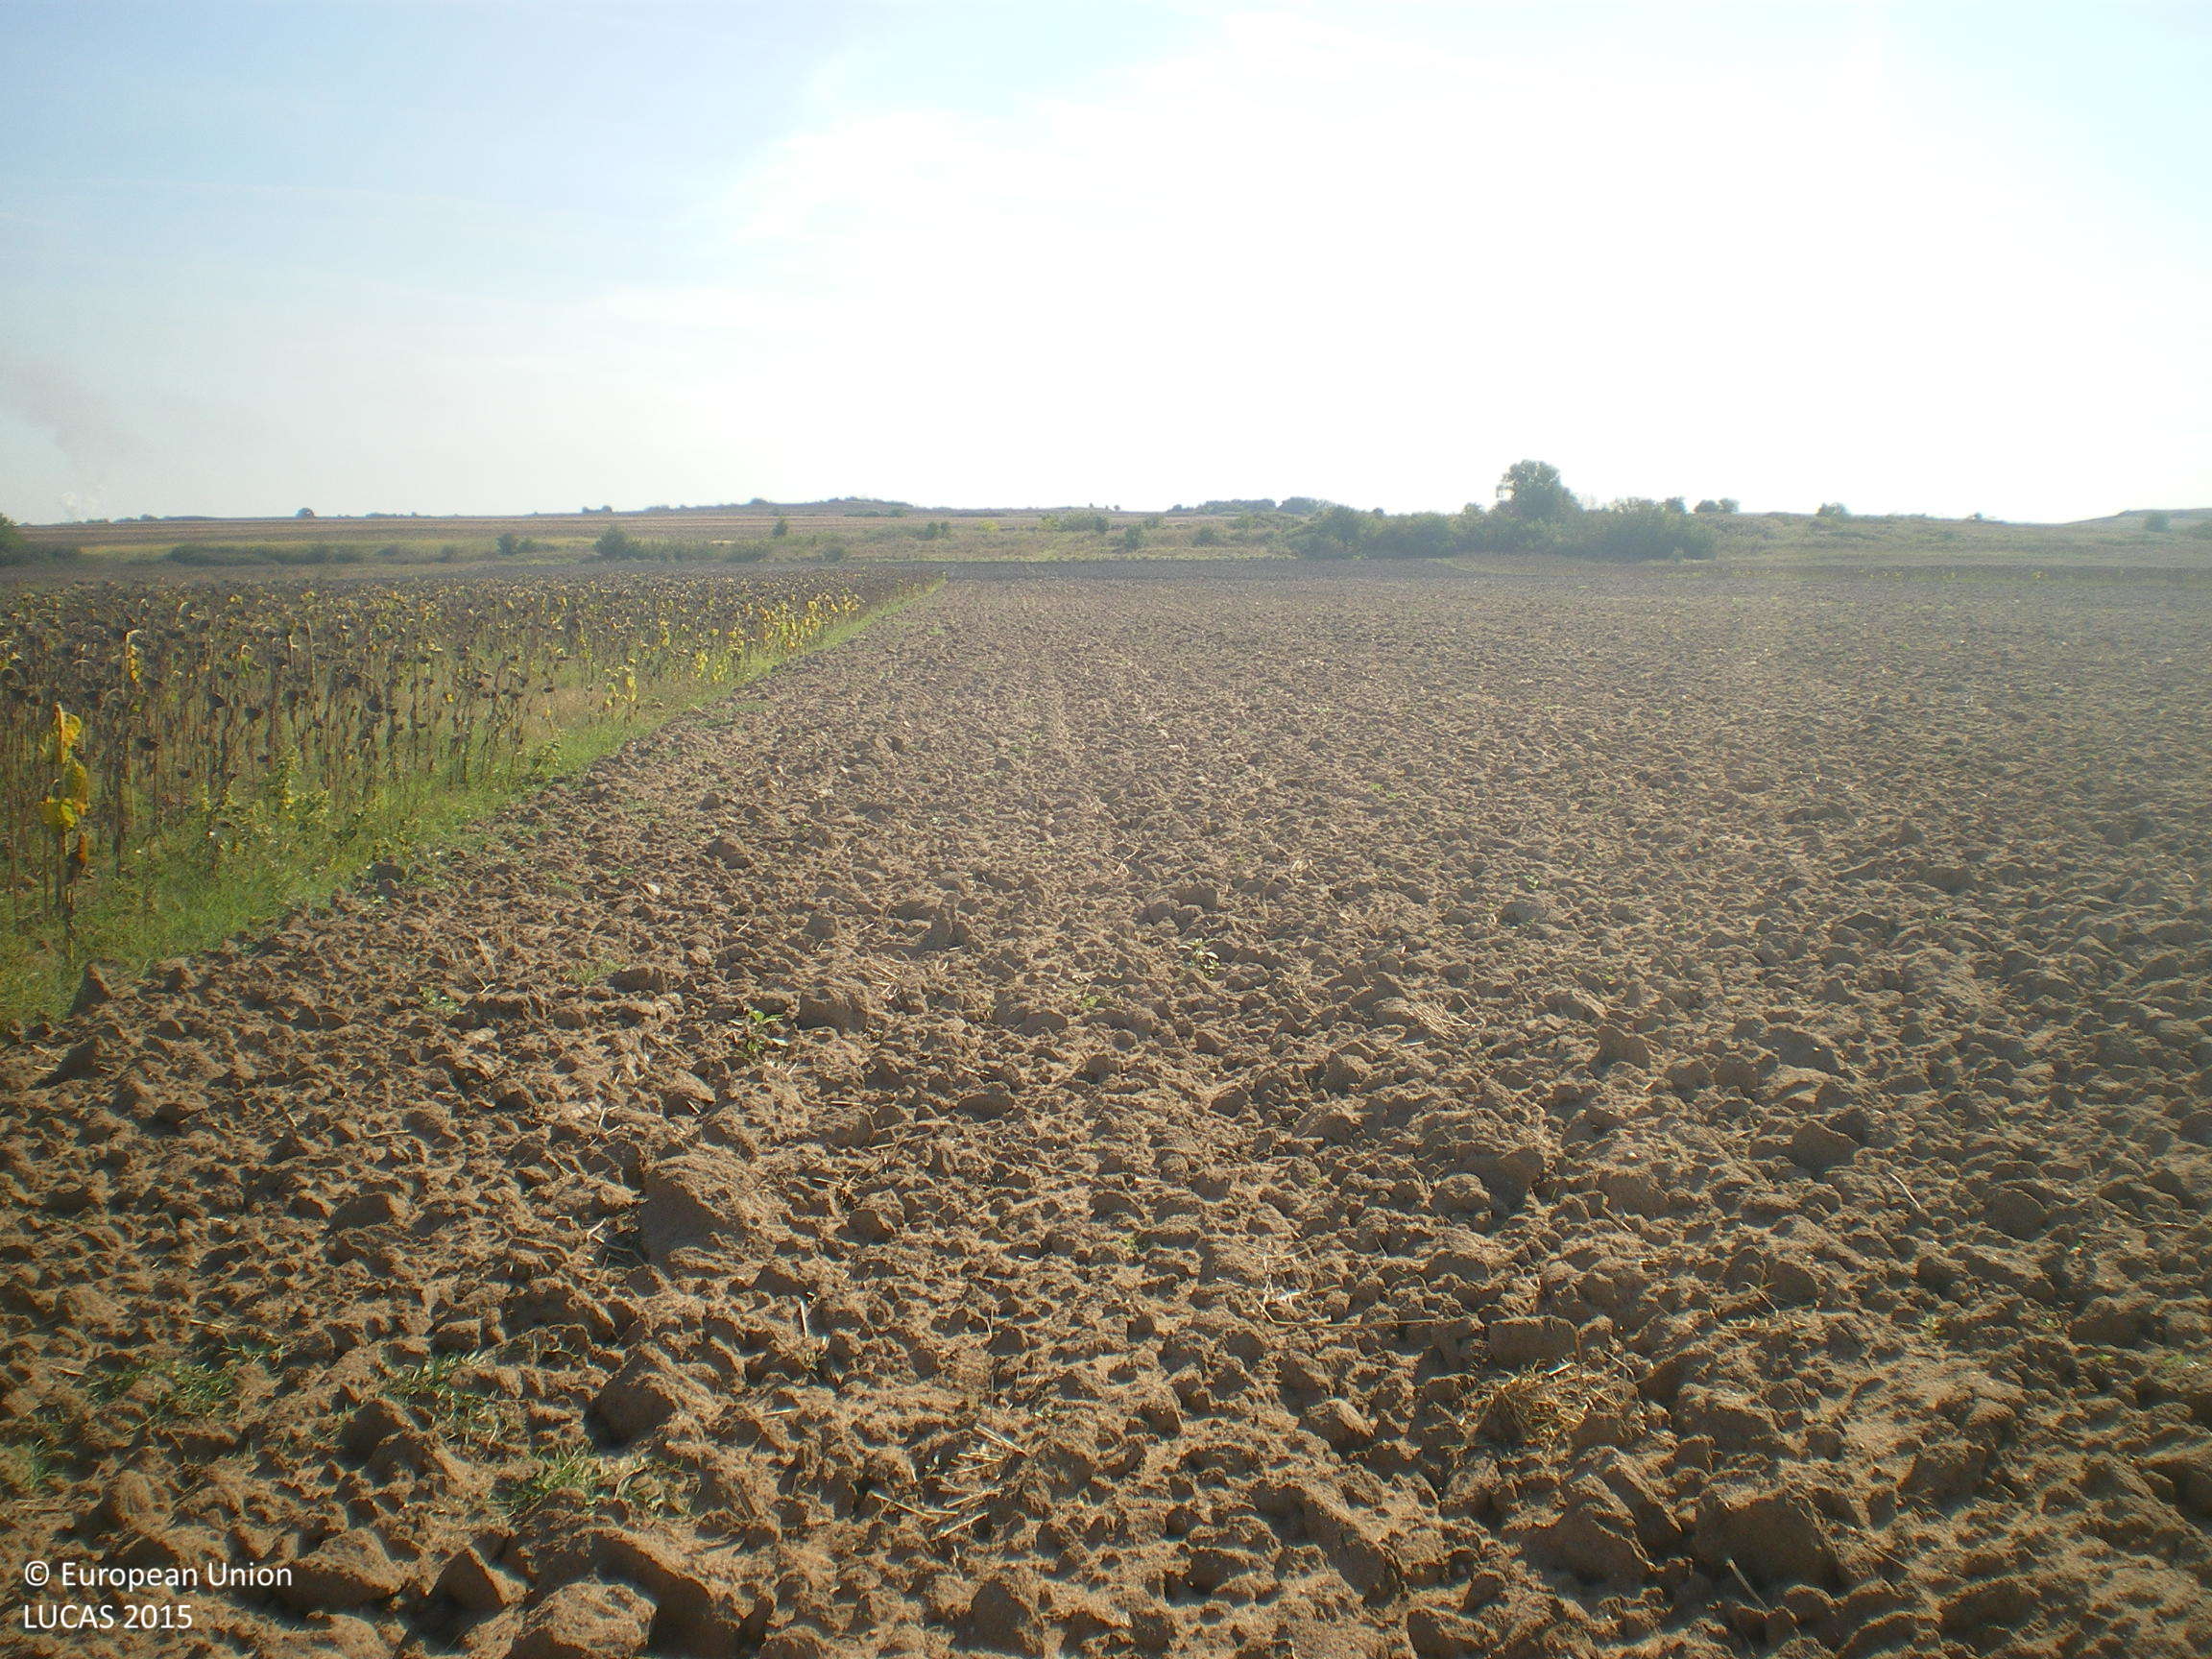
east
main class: Cropland
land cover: Common wheat
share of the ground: < 10 %
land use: Agriculture (excluding fallow land and kitchen gardens)
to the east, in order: Common wheat
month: September
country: BG
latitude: 42.1085
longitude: 25.8792
